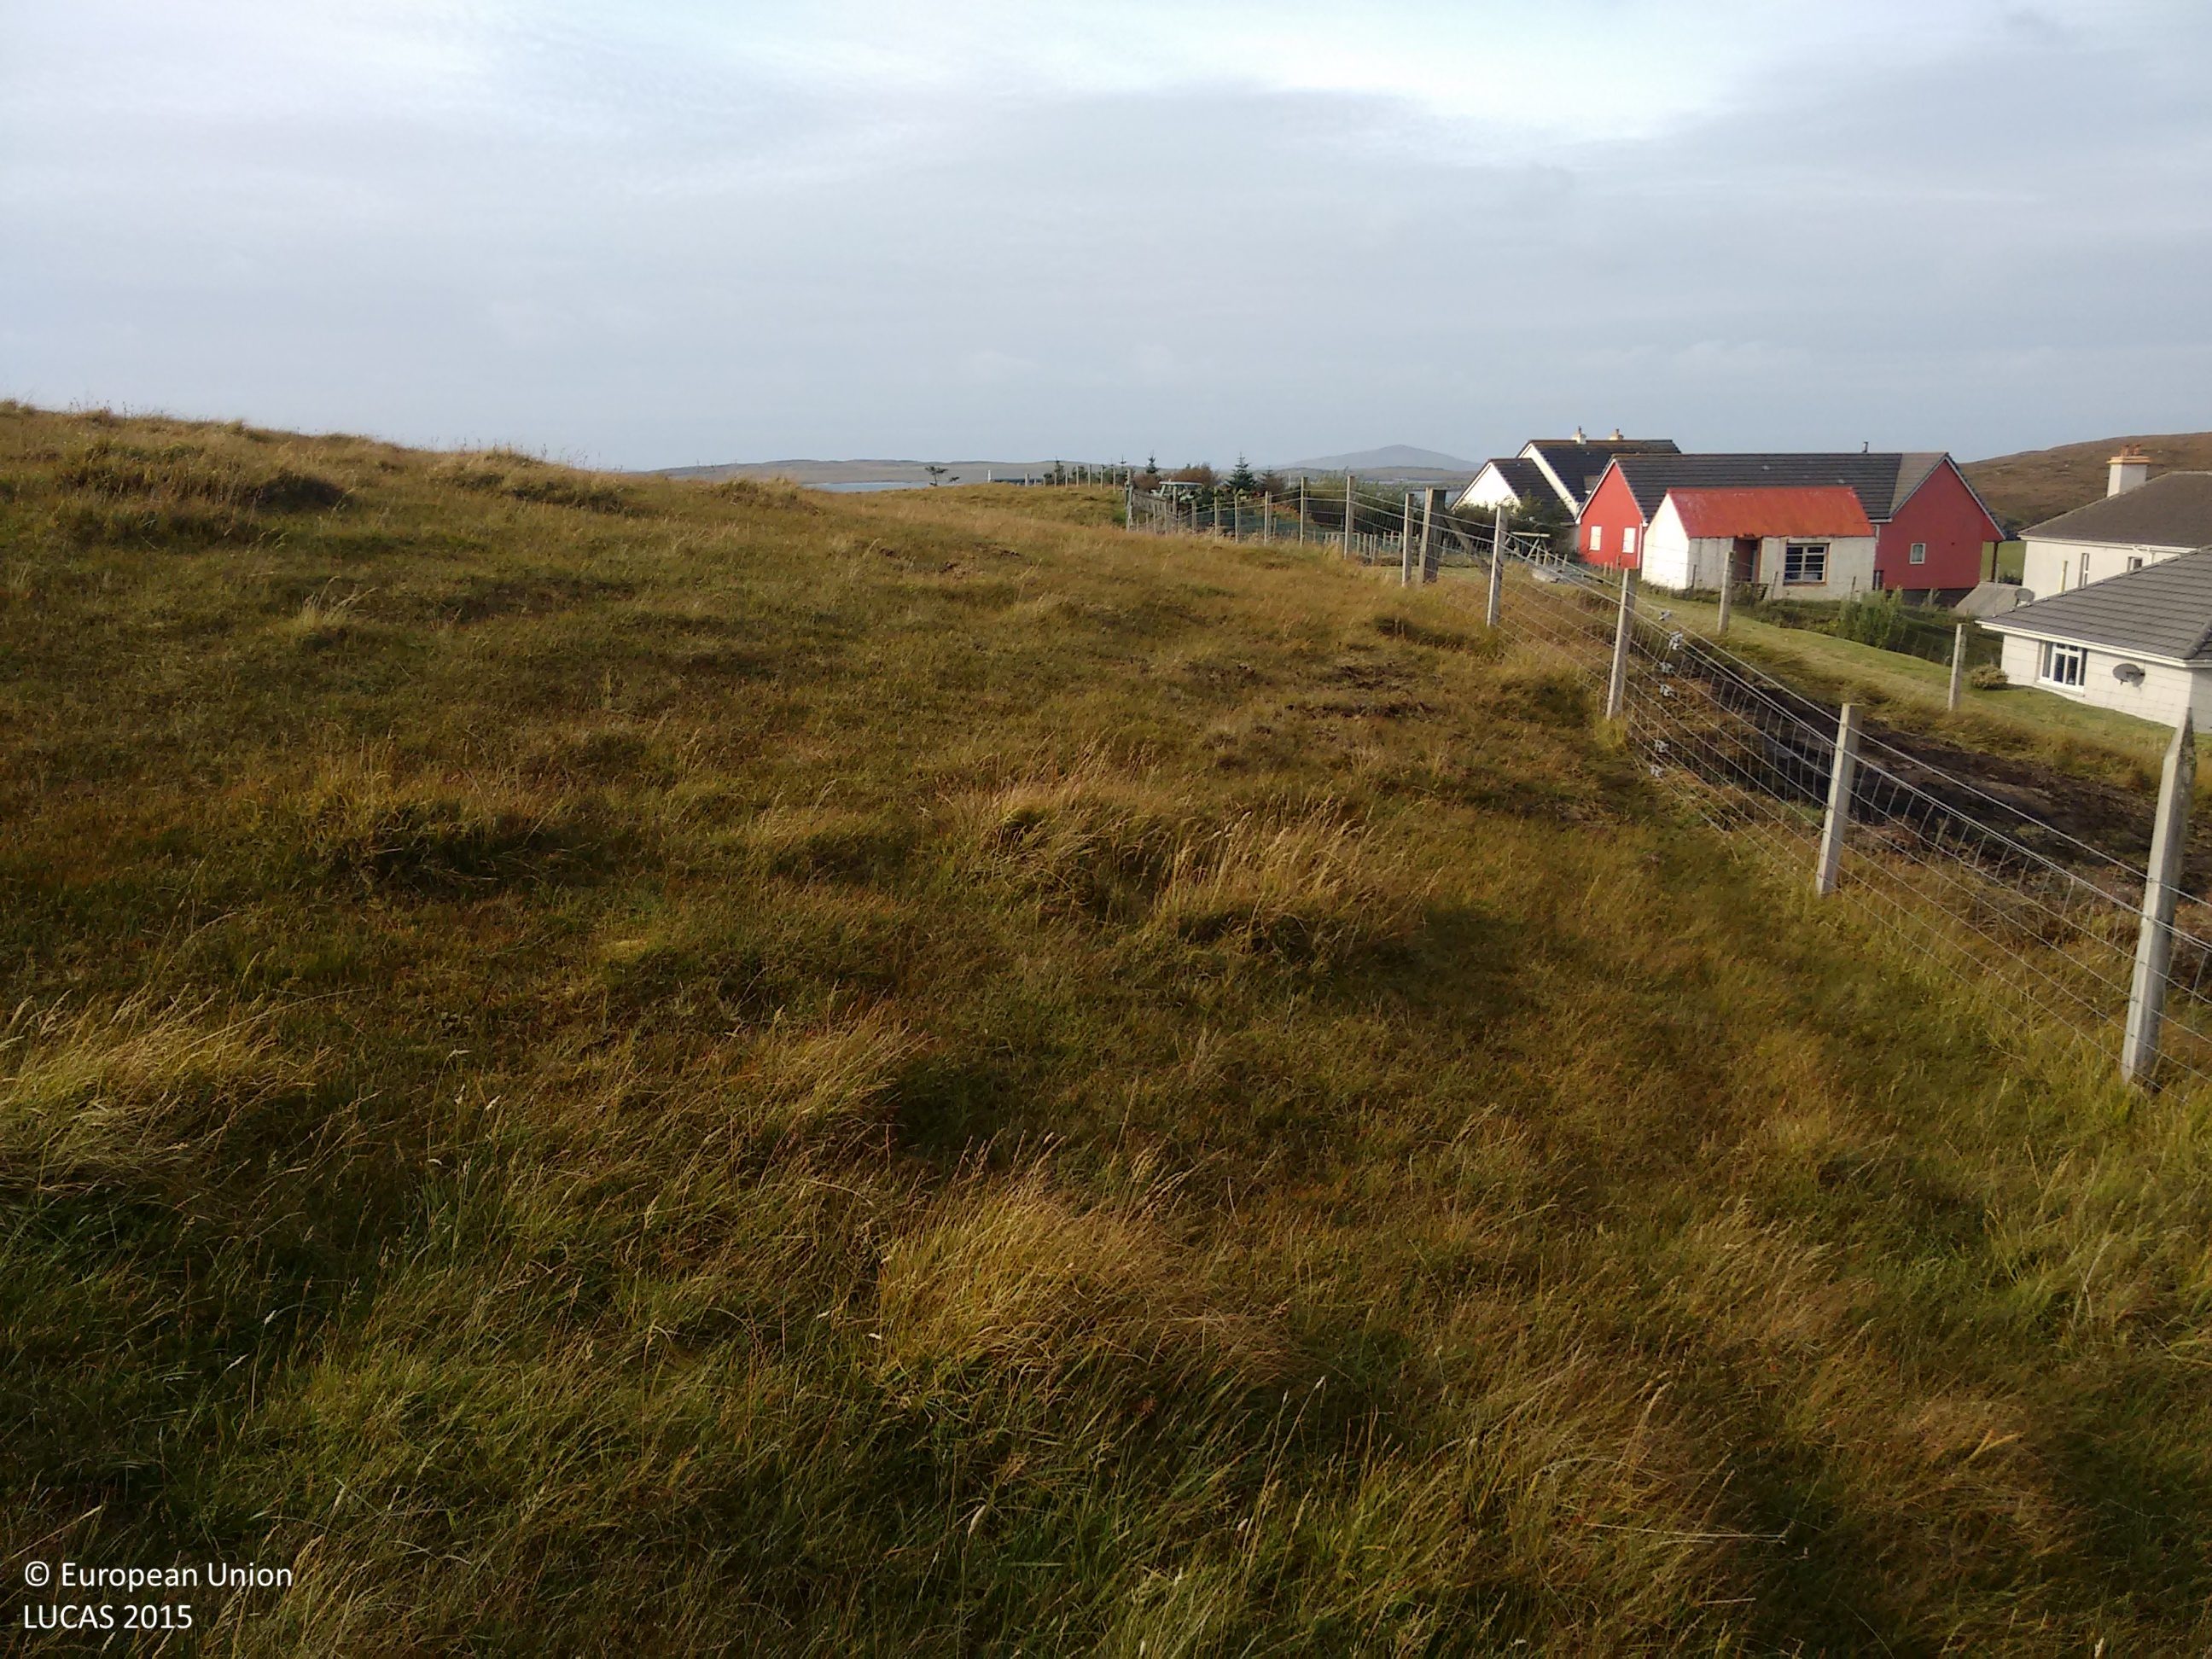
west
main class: Grassland
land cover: Grassland without tree/shrub cover
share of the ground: > 75 %
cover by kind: herbaceous plants 100 %
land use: Agriculture (excluding fallow land and kitchen gardens)
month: October
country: GB
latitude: 57.7673
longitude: -7.0174
